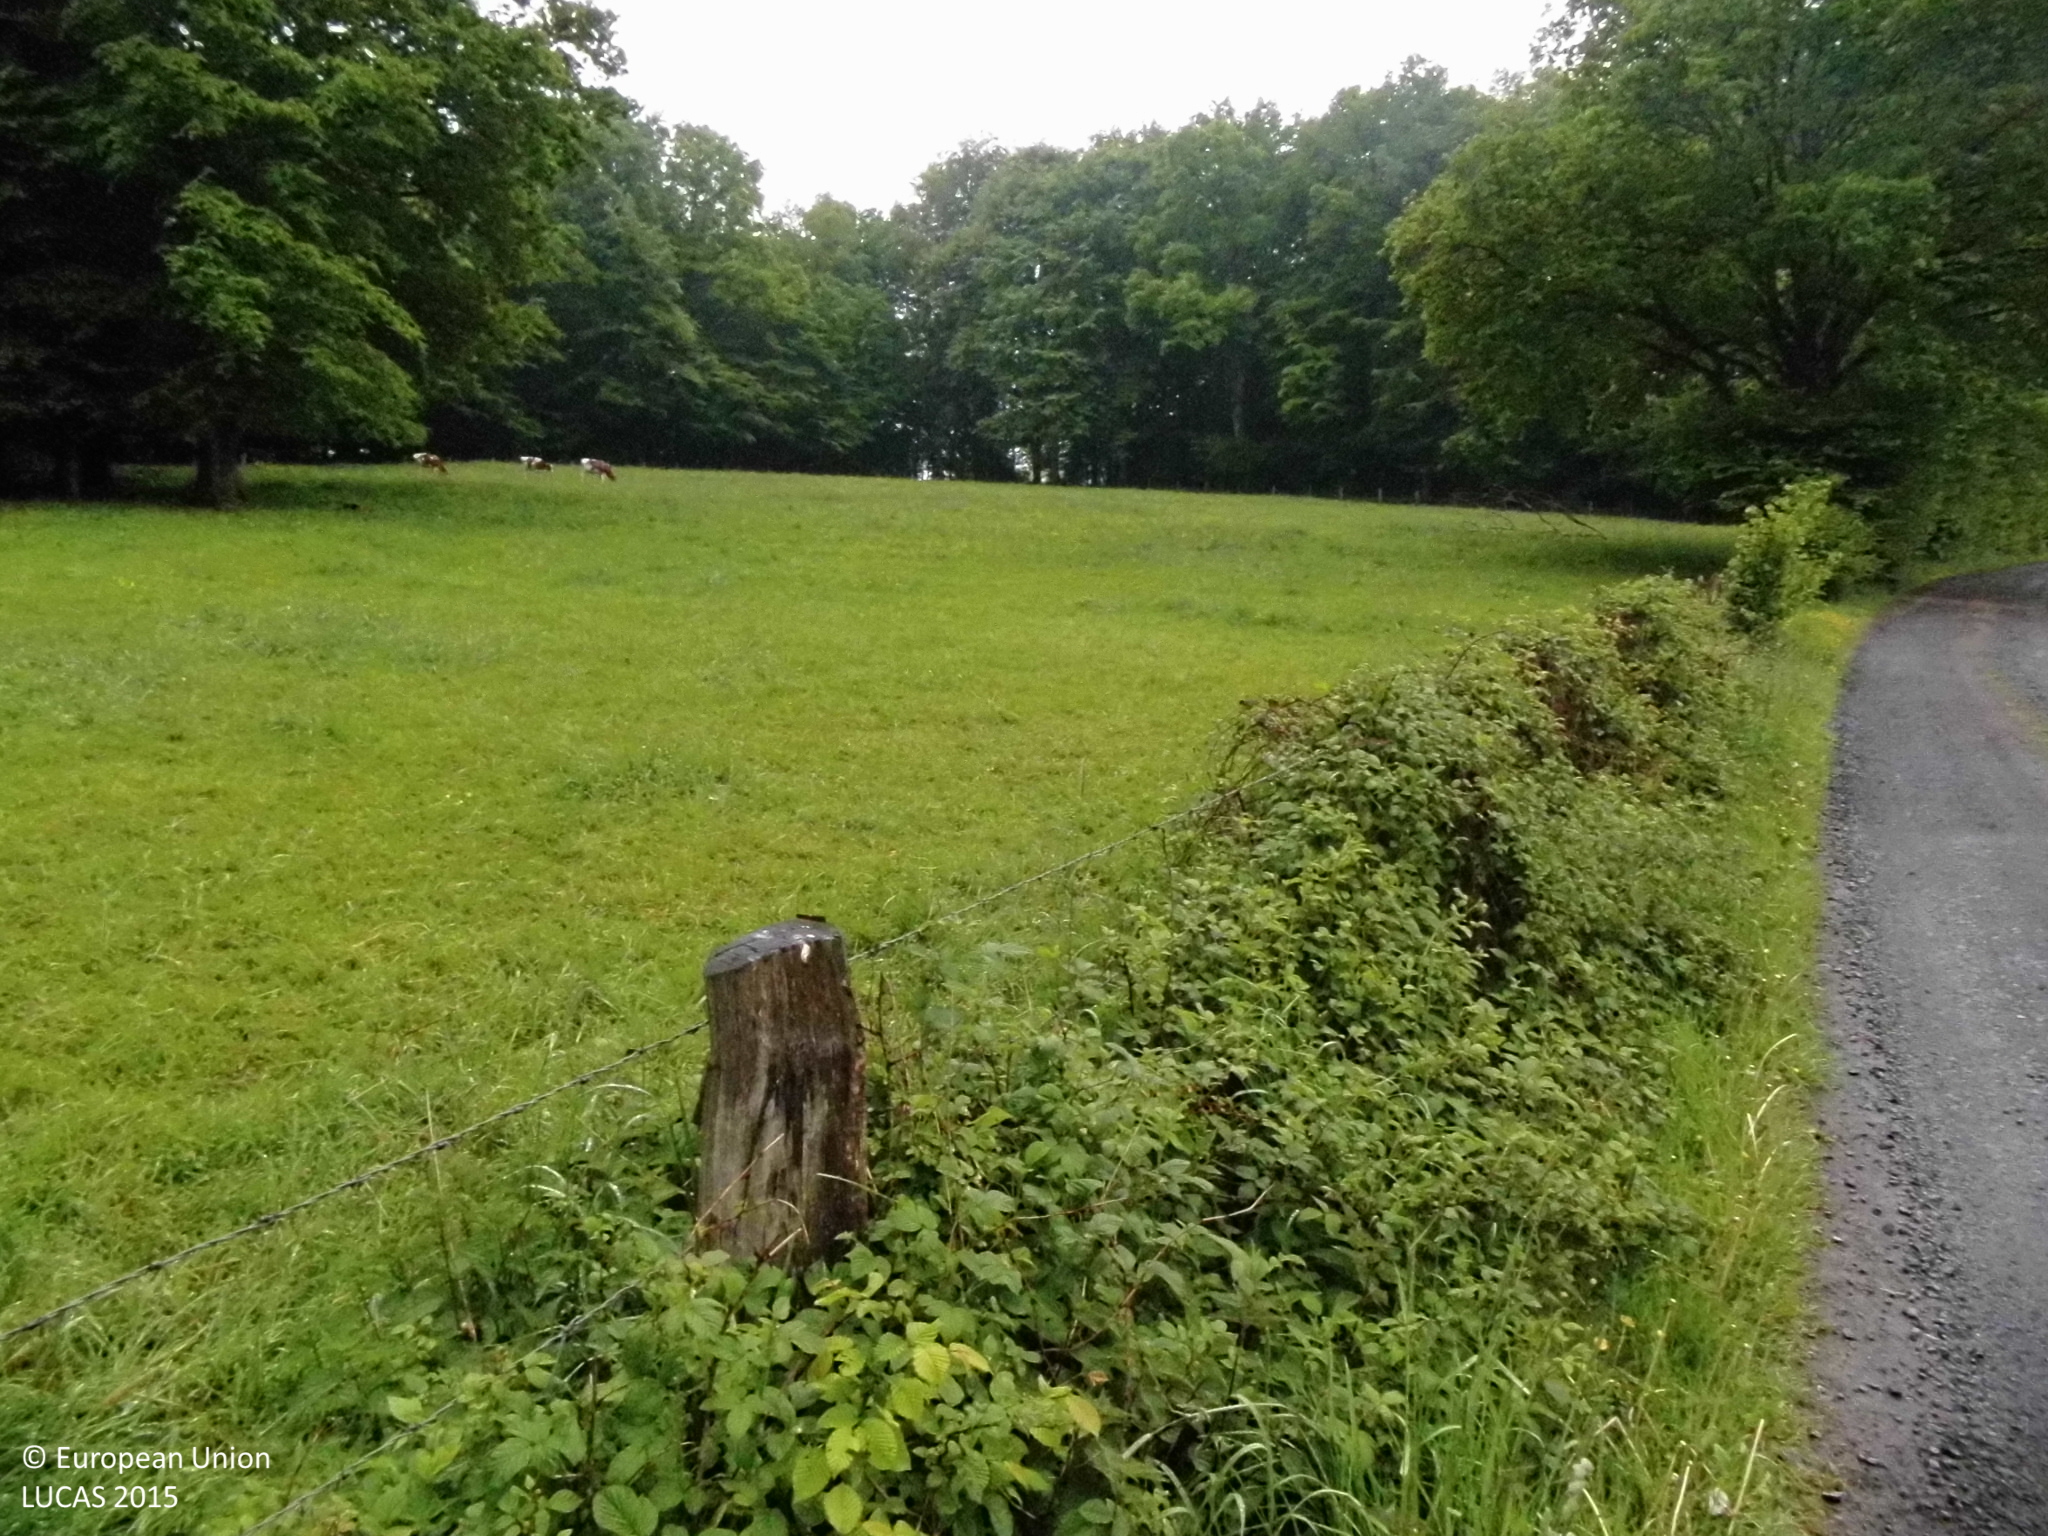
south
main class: Grassland
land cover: Grassland without tree/shrub cover
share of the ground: > 75 %
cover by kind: herbaceous plants 100 %
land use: Agriculture (excluding fallow land and kitchen gardens)
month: May
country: DE
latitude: 50.6605
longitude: 7.4963
